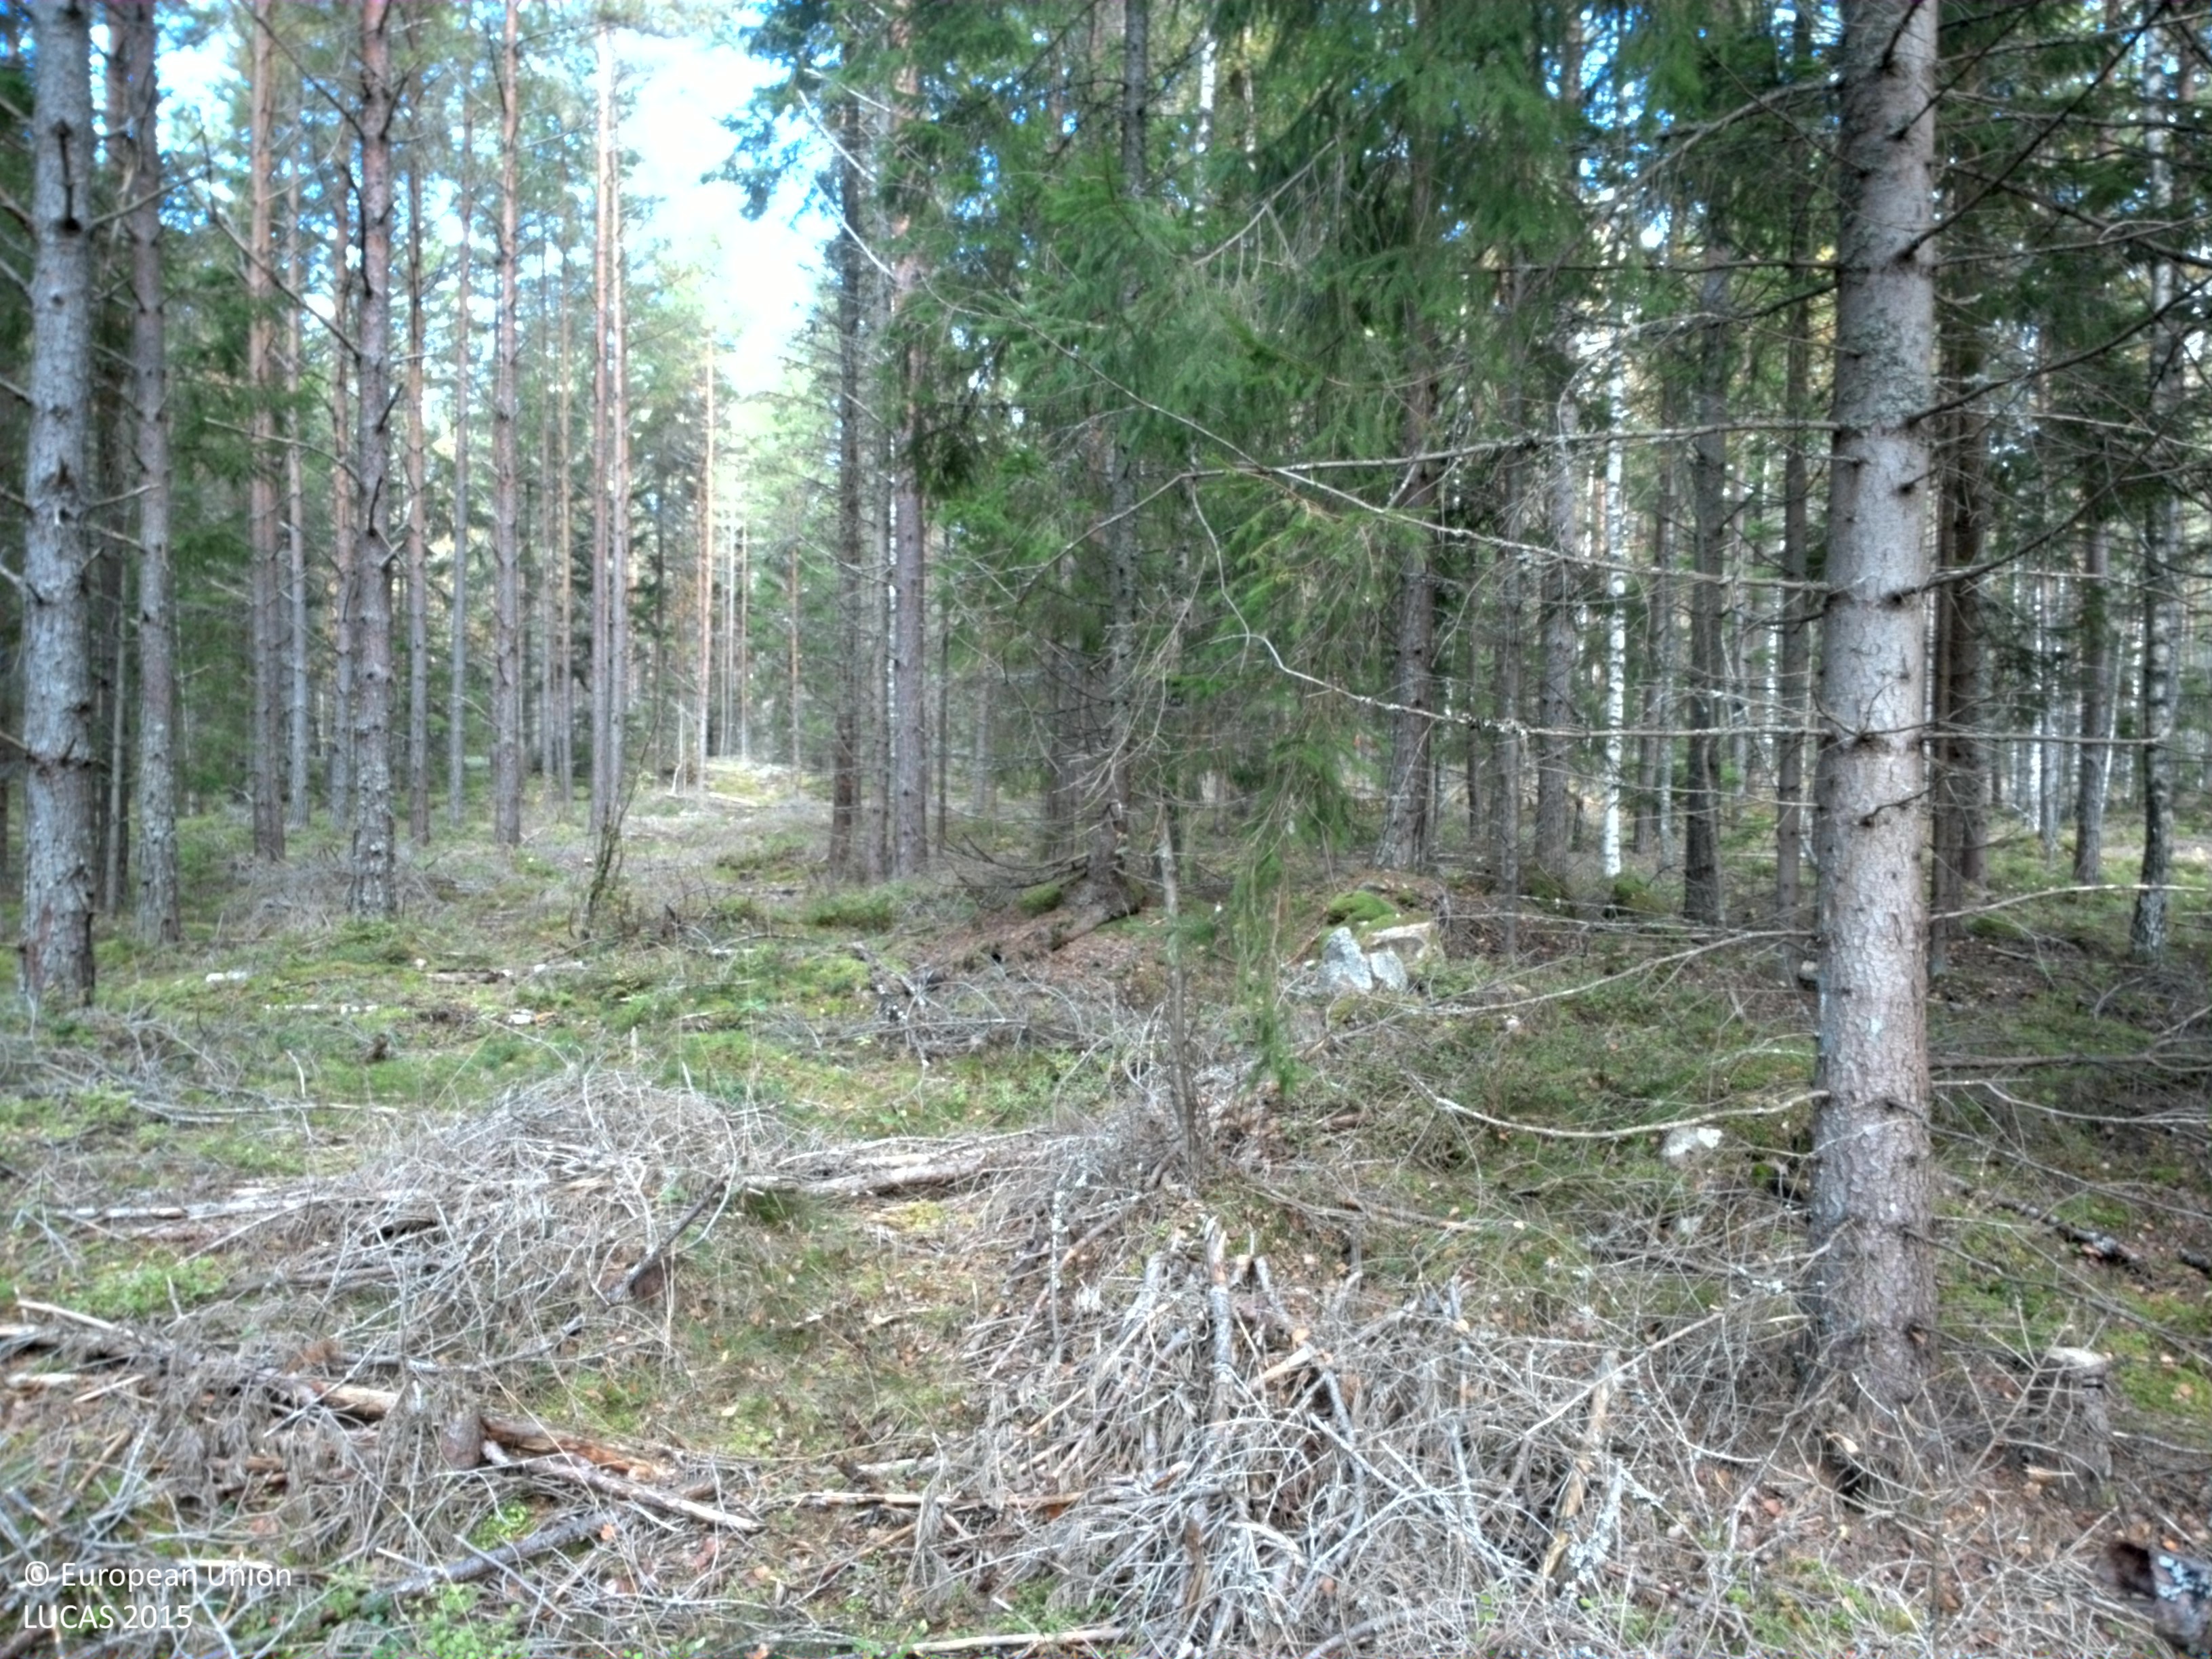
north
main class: Woodland
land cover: Pine dominated mixed woodland
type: boreal forest
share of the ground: 10 - 25 %
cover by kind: shrubs 40 %, lichens and mosses 35 %, coniferous forest trees 15 %, broadleaved forest trees 10 %
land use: Forestry
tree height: > 5 m
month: September
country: SE
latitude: 59.2028
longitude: 14.0719
